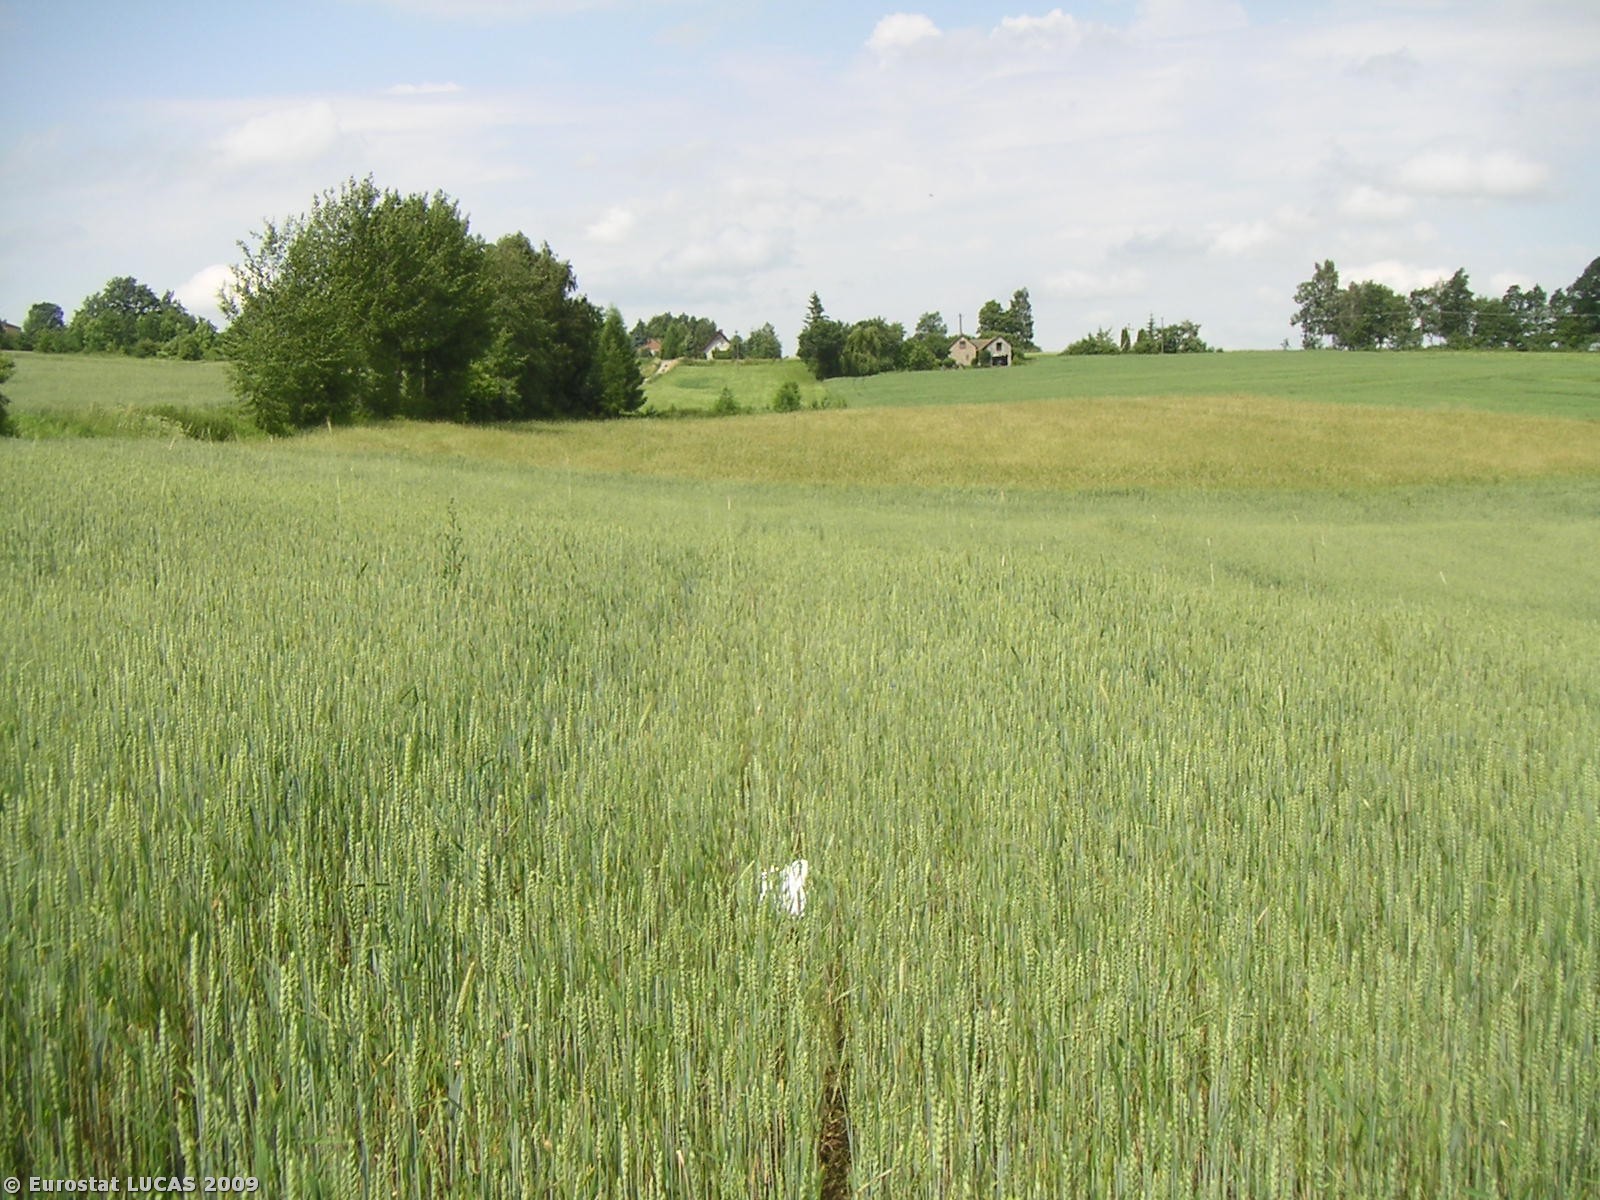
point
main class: Cropland
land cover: Common wheat
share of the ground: > 75 %
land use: Agriculture (excluding fallow land and kitchen gardens)
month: June
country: PL
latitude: 50.4301
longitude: 19.8145
